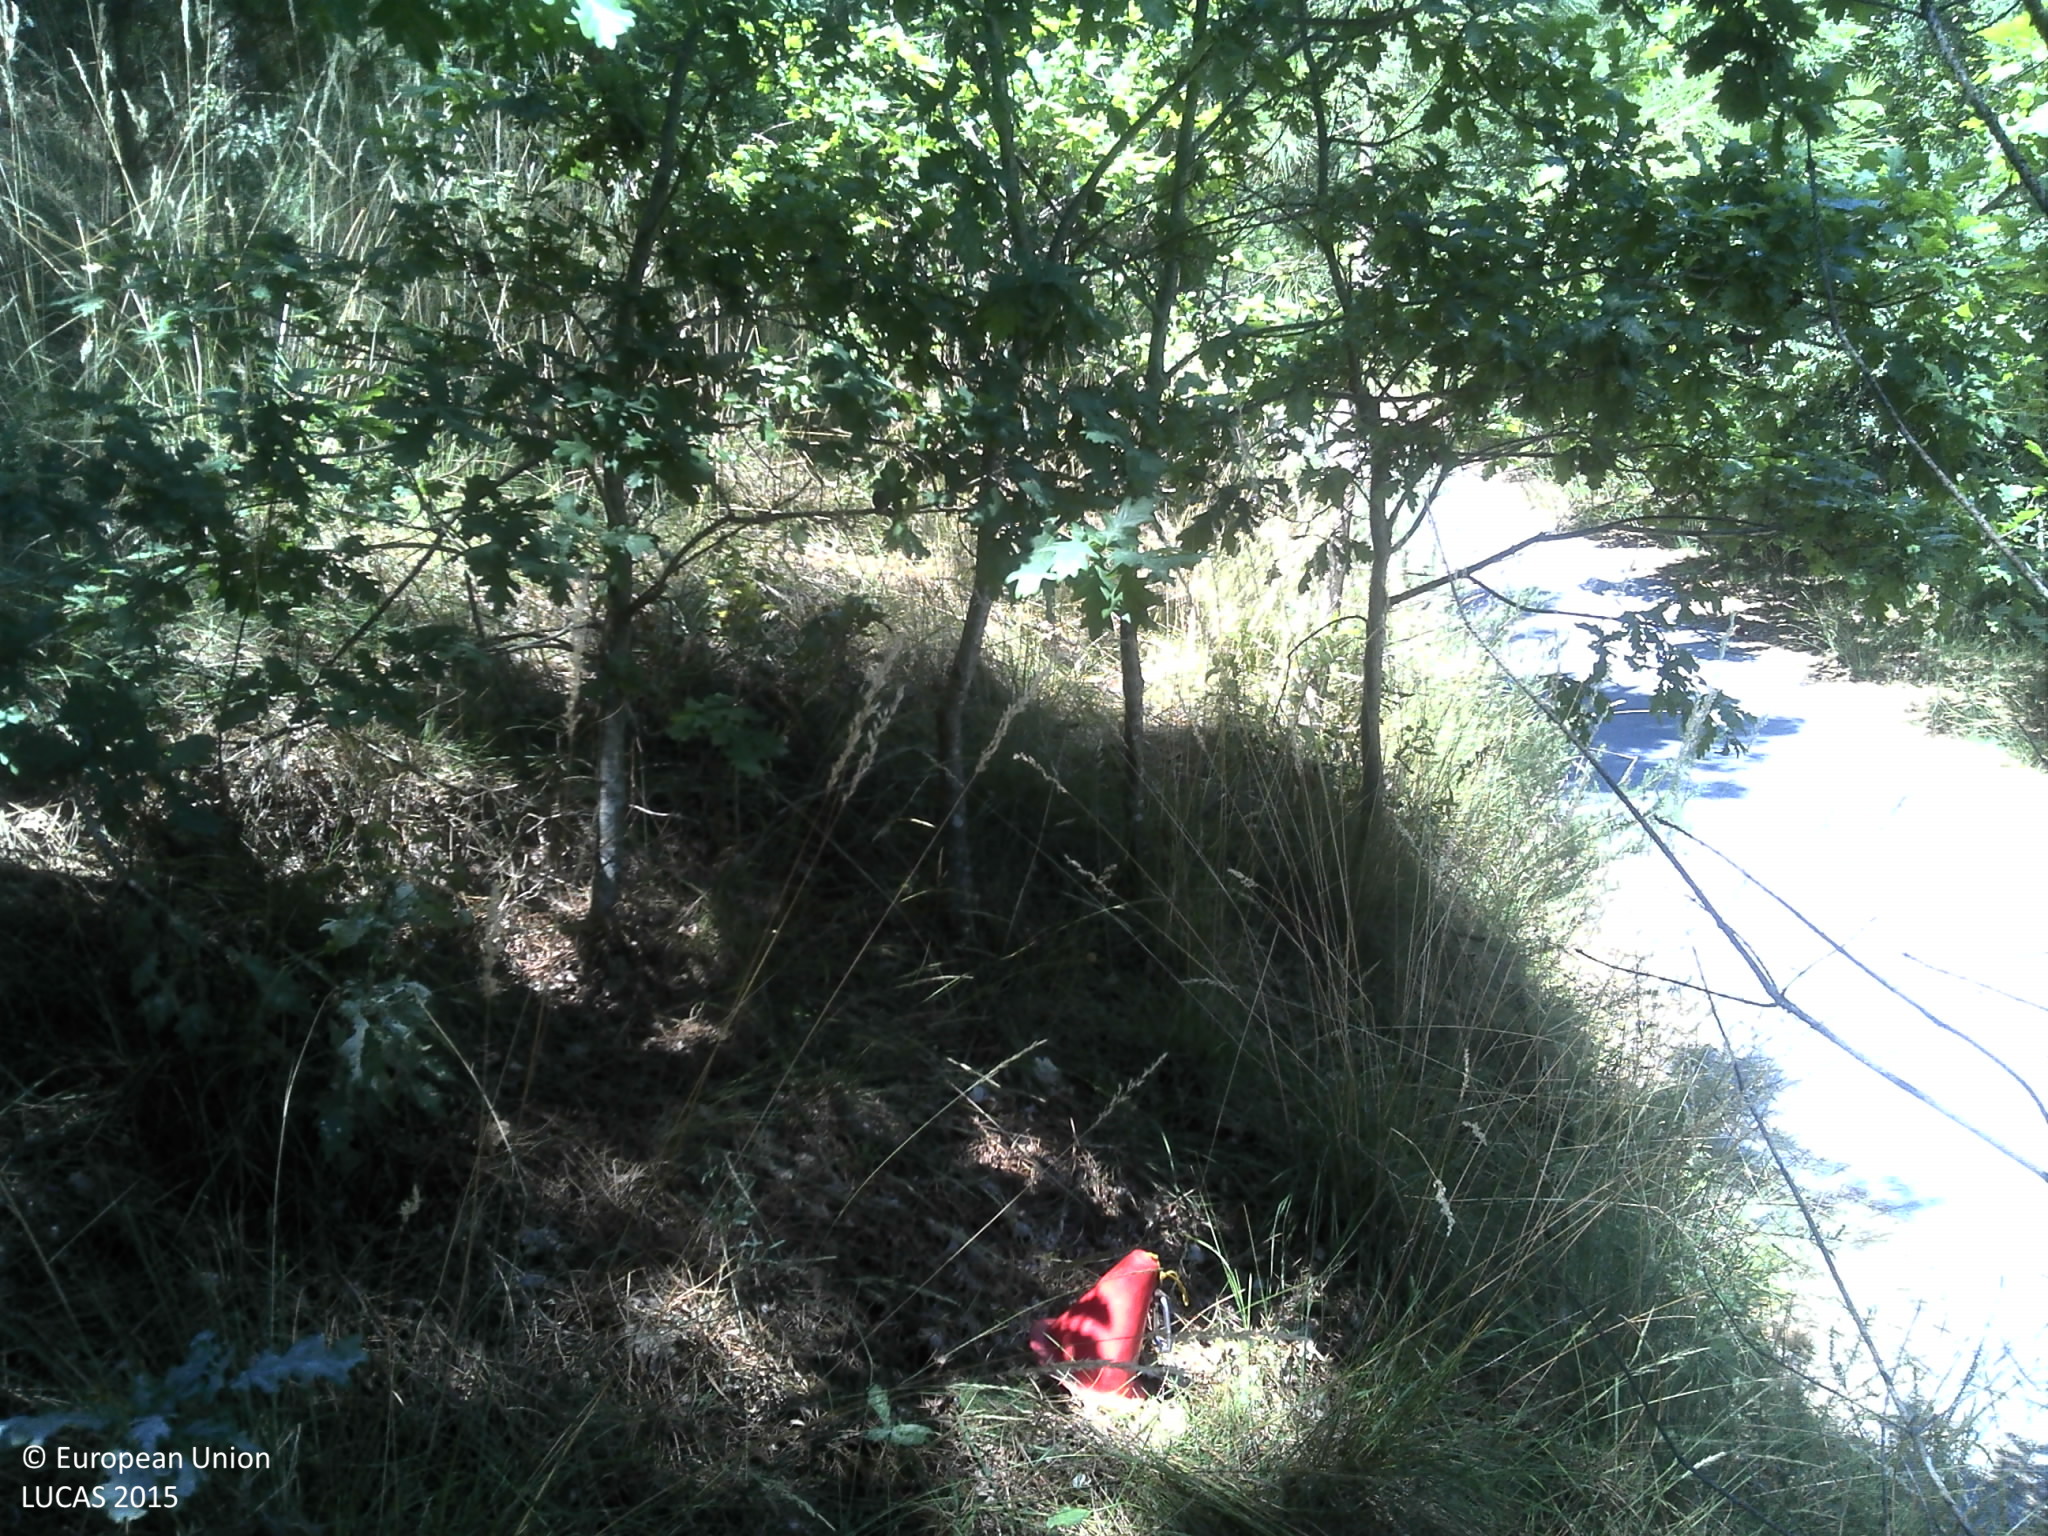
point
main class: Woodland
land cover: Pine dominated coniferous woodland
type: coniferous forest of the mediterranean region
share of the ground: > 75 %
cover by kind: coniferous forest trees 75 %, shrubs 15 %, broadleaved forest trees 5 %, unconsolidated bare surface 5 %
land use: Forestry
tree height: > 5 m
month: June
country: PT
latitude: 41.4089
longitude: -8.0242
